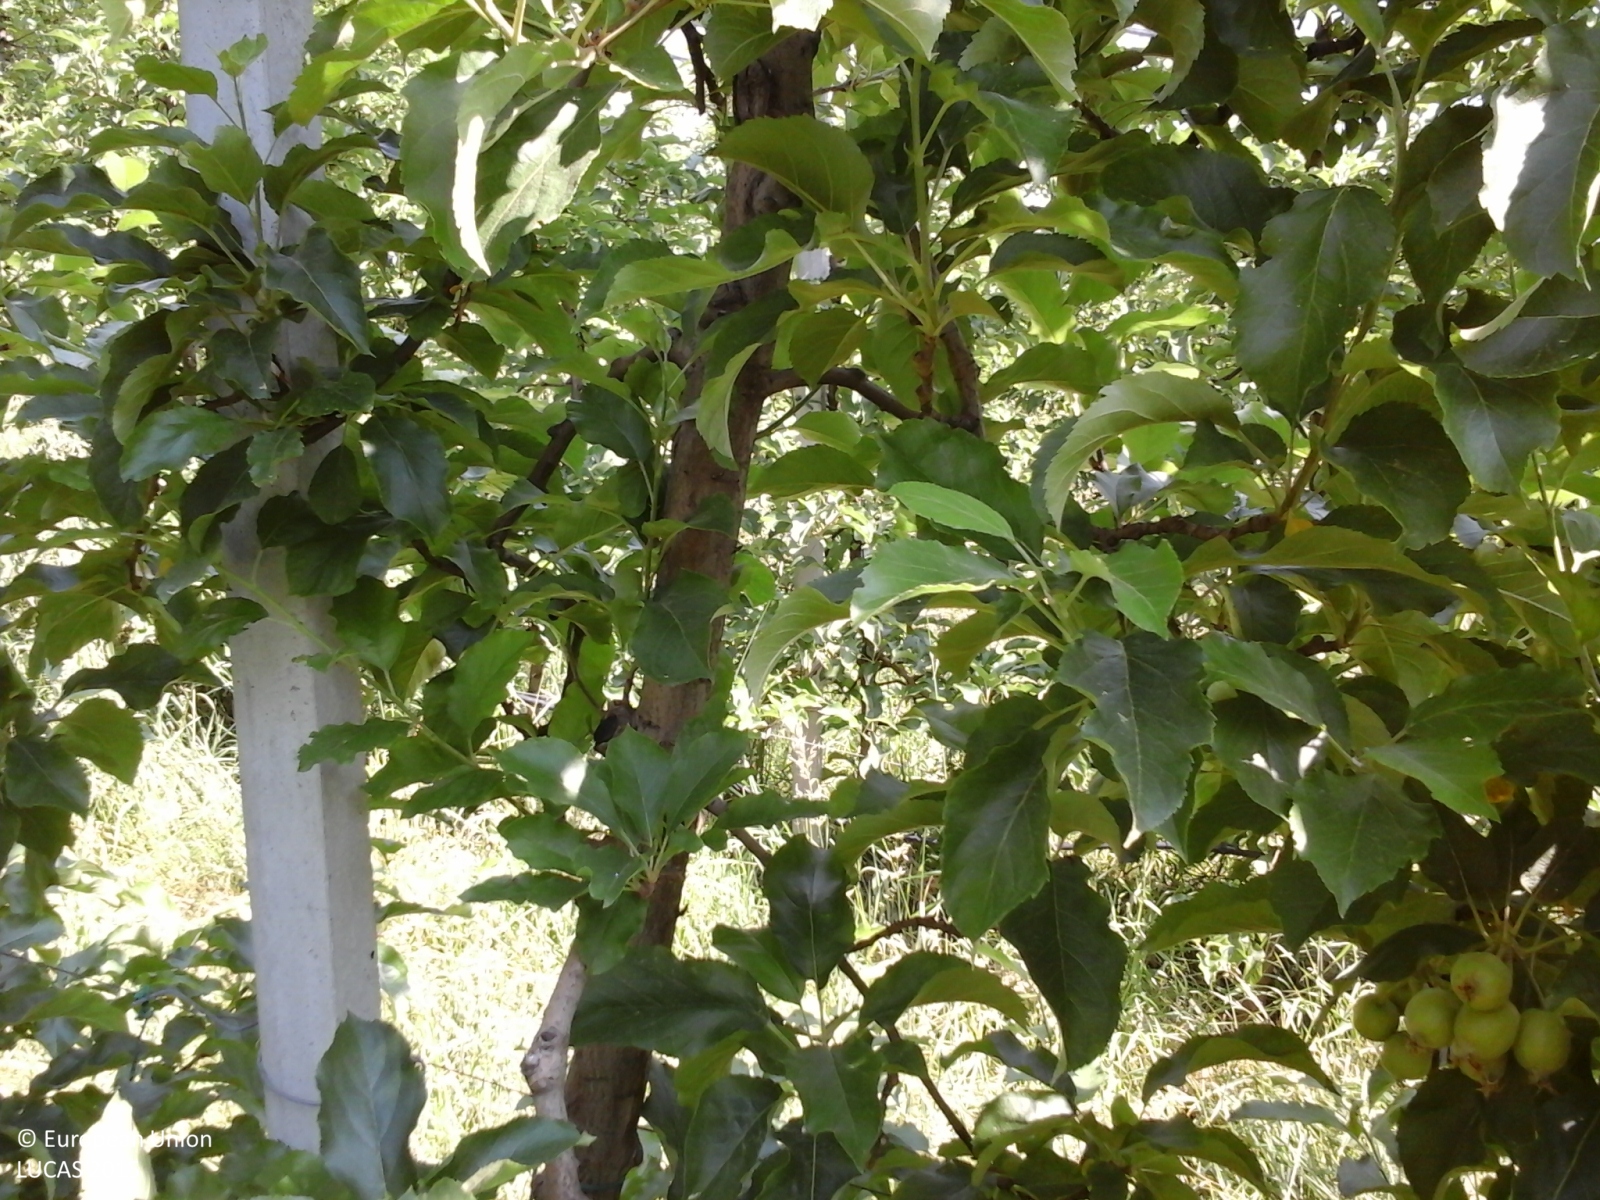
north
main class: Cropland
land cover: Apple fruit
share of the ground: > 75 %
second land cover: Grassland without tree/shrub cover
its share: > 75 %
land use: Agriculture (excluding fallow land and kitchen gardens)
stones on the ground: < 10 %
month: May
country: IT
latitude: 46.6154
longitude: 11.1347
